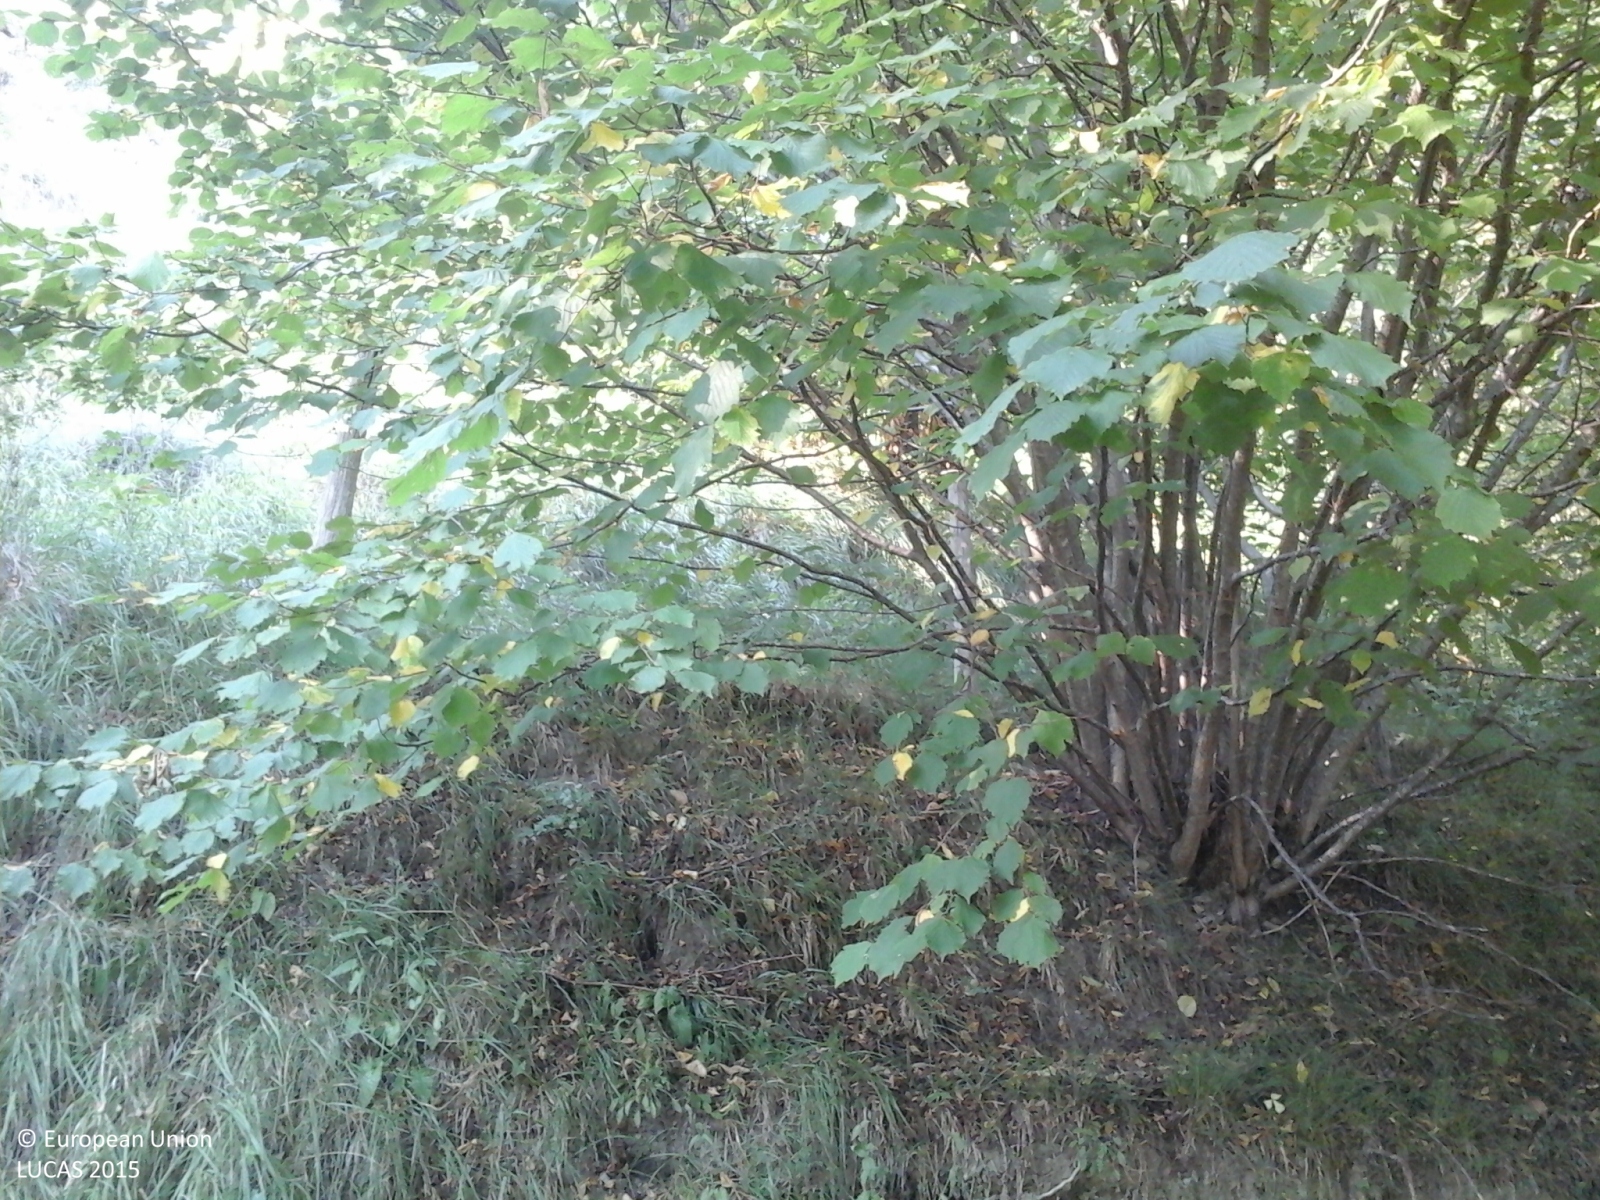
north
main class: Grassland
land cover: Grassland with sparse tree/shrub cover
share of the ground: > 75 %
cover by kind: herbaceous plants 85 %, shrubs 10 %, broadleaved forest trees 5 %
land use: Semi-natural and natural areas not in use
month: August
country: IT
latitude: 44.4035
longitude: 9.5114
